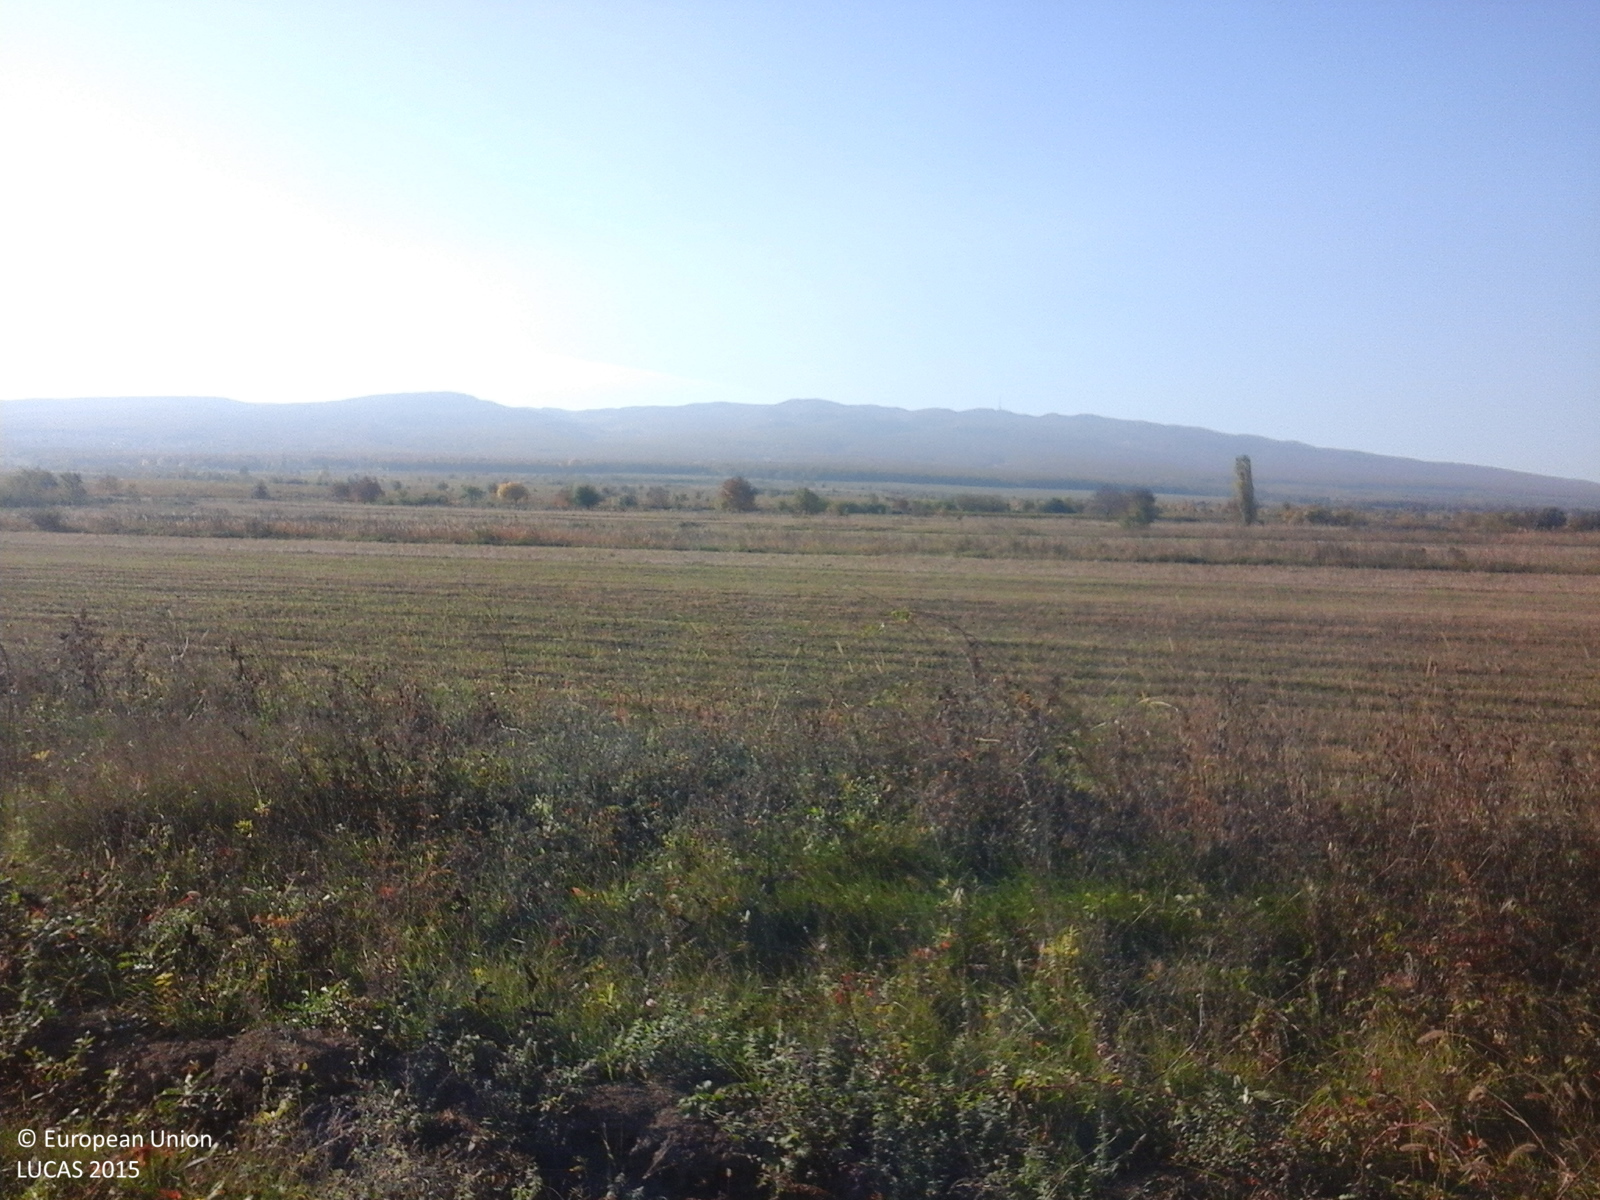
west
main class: Grassland
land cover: Spontaneously vegetated surfaces
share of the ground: > 75 %
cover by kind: herbaceous plants 100 %
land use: Fallow land
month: October
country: RO
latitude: 45.8301
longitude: 27.0723
